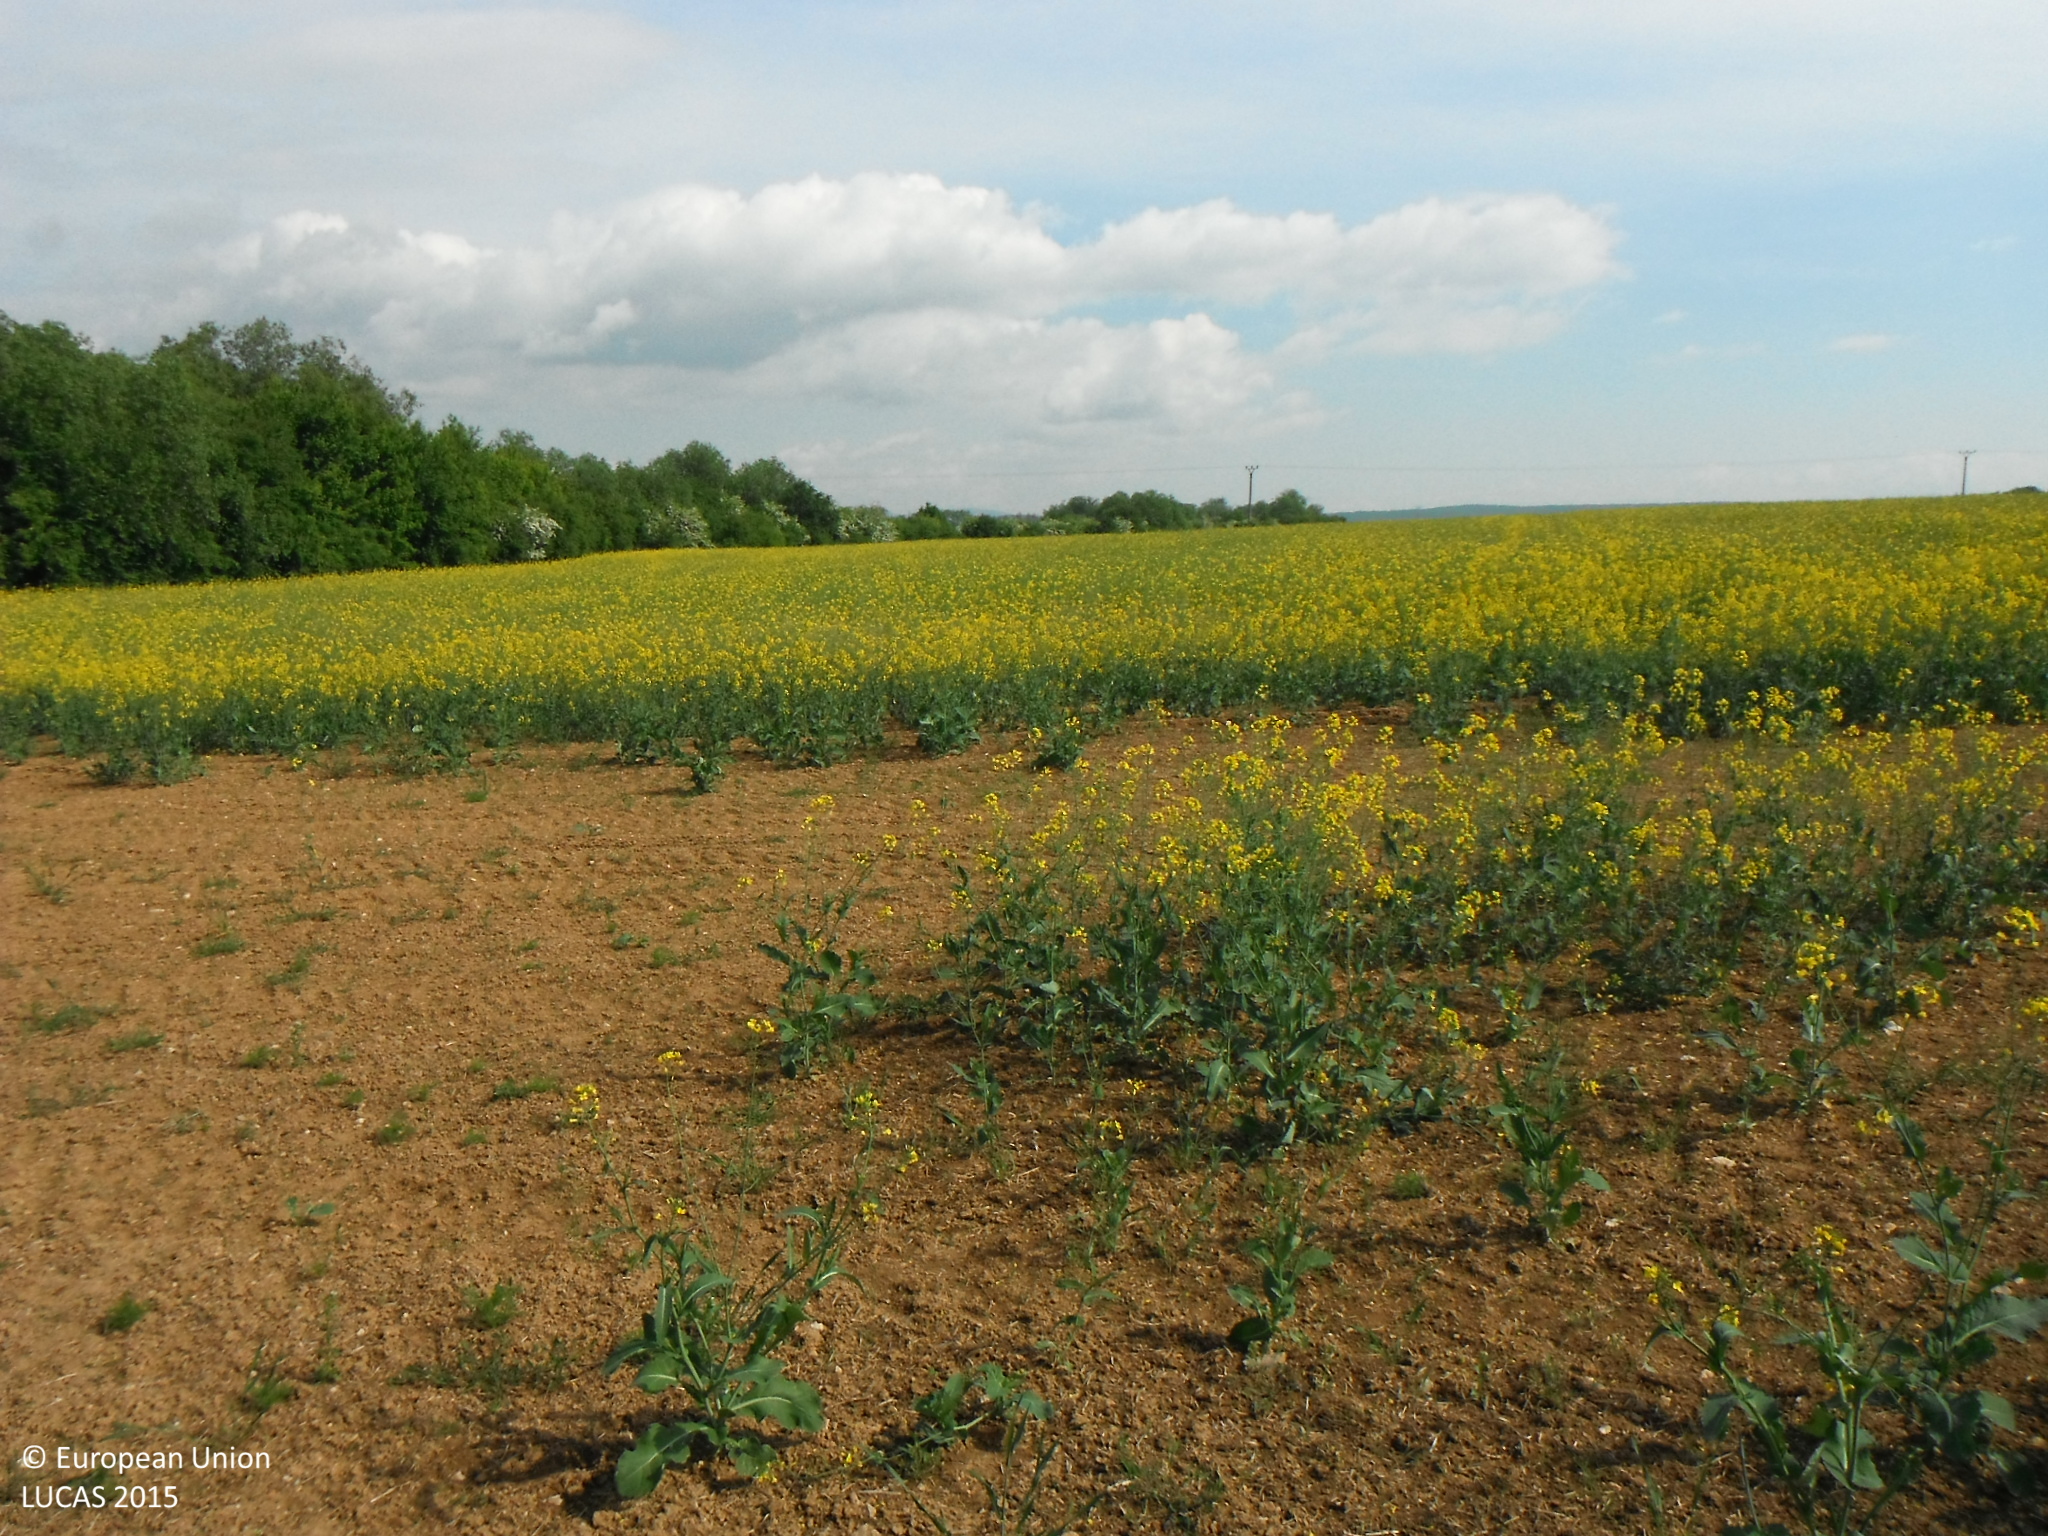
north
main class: Cropland
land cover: Rape and turnip rape
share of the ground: < 10 %
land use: Agriculture (excluding fallow land and kitchen gardens)
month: May
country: SK
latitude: 48.6005
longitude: 21.1489
